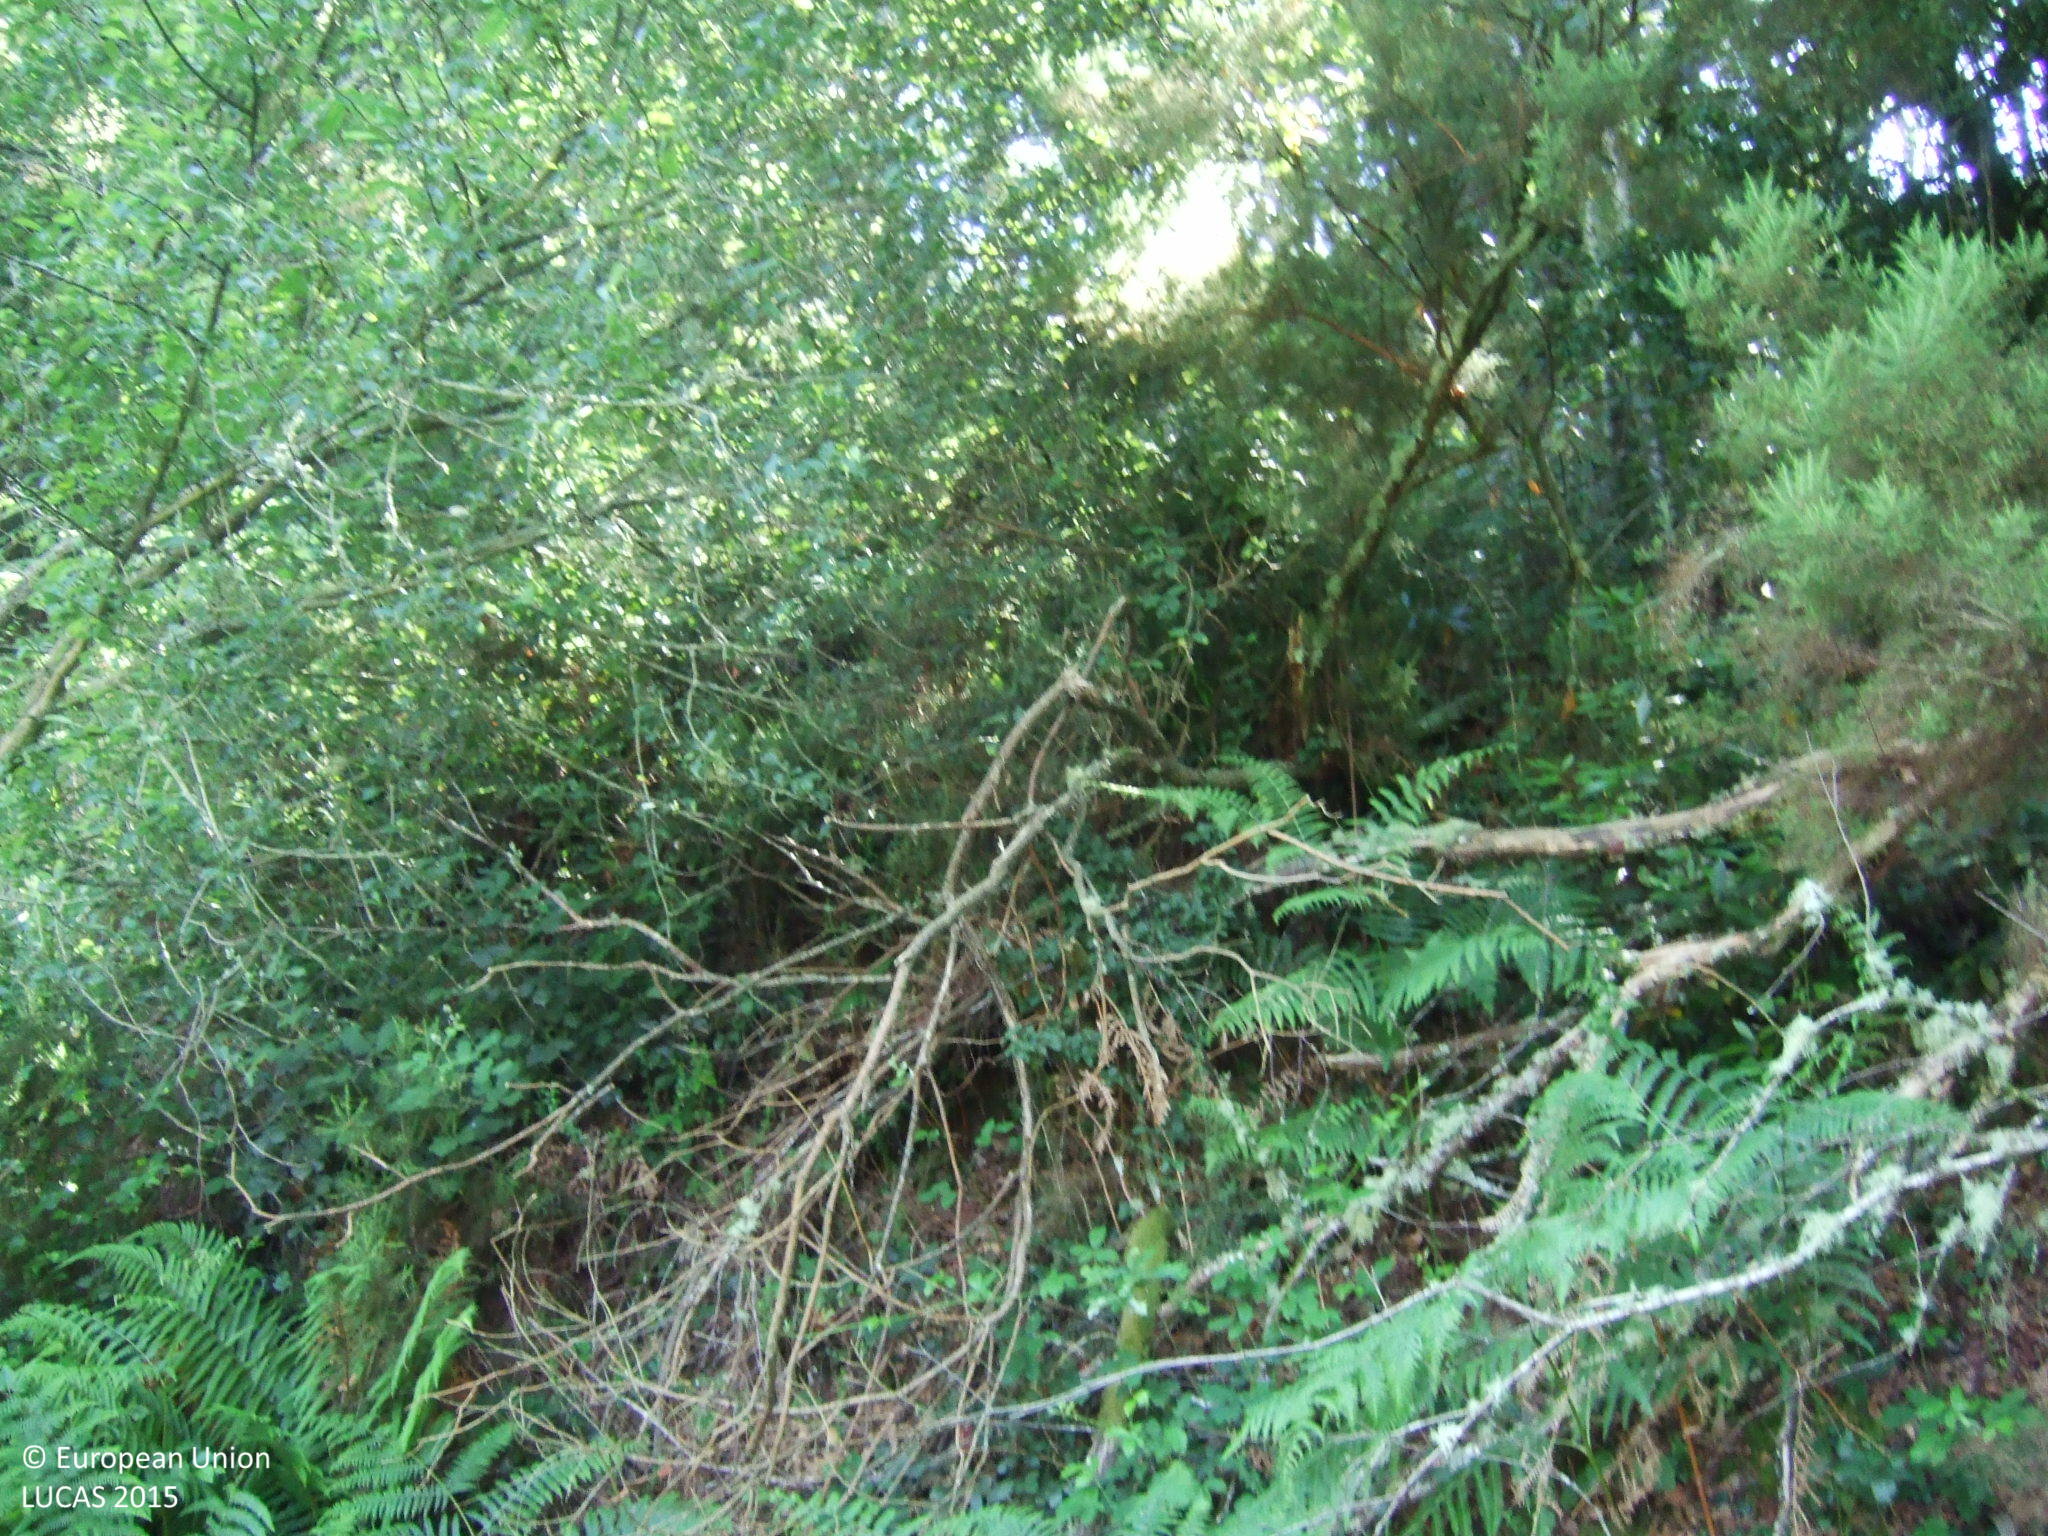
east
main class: Woodland
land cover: Broadleaved woodland
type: acidophilous oak and oak-birch forest
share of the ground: > 75 %
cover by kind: broadleaved forest trees 85 %, shrubs 15 %
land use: Forestry
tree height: > 5 m
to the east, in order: Broadleaved woodland; Inland fresh running water; Broadleaved woodland; Grassland without tree/shrub cover
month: June
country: ES
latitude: 43.5426
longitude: -7.7500
